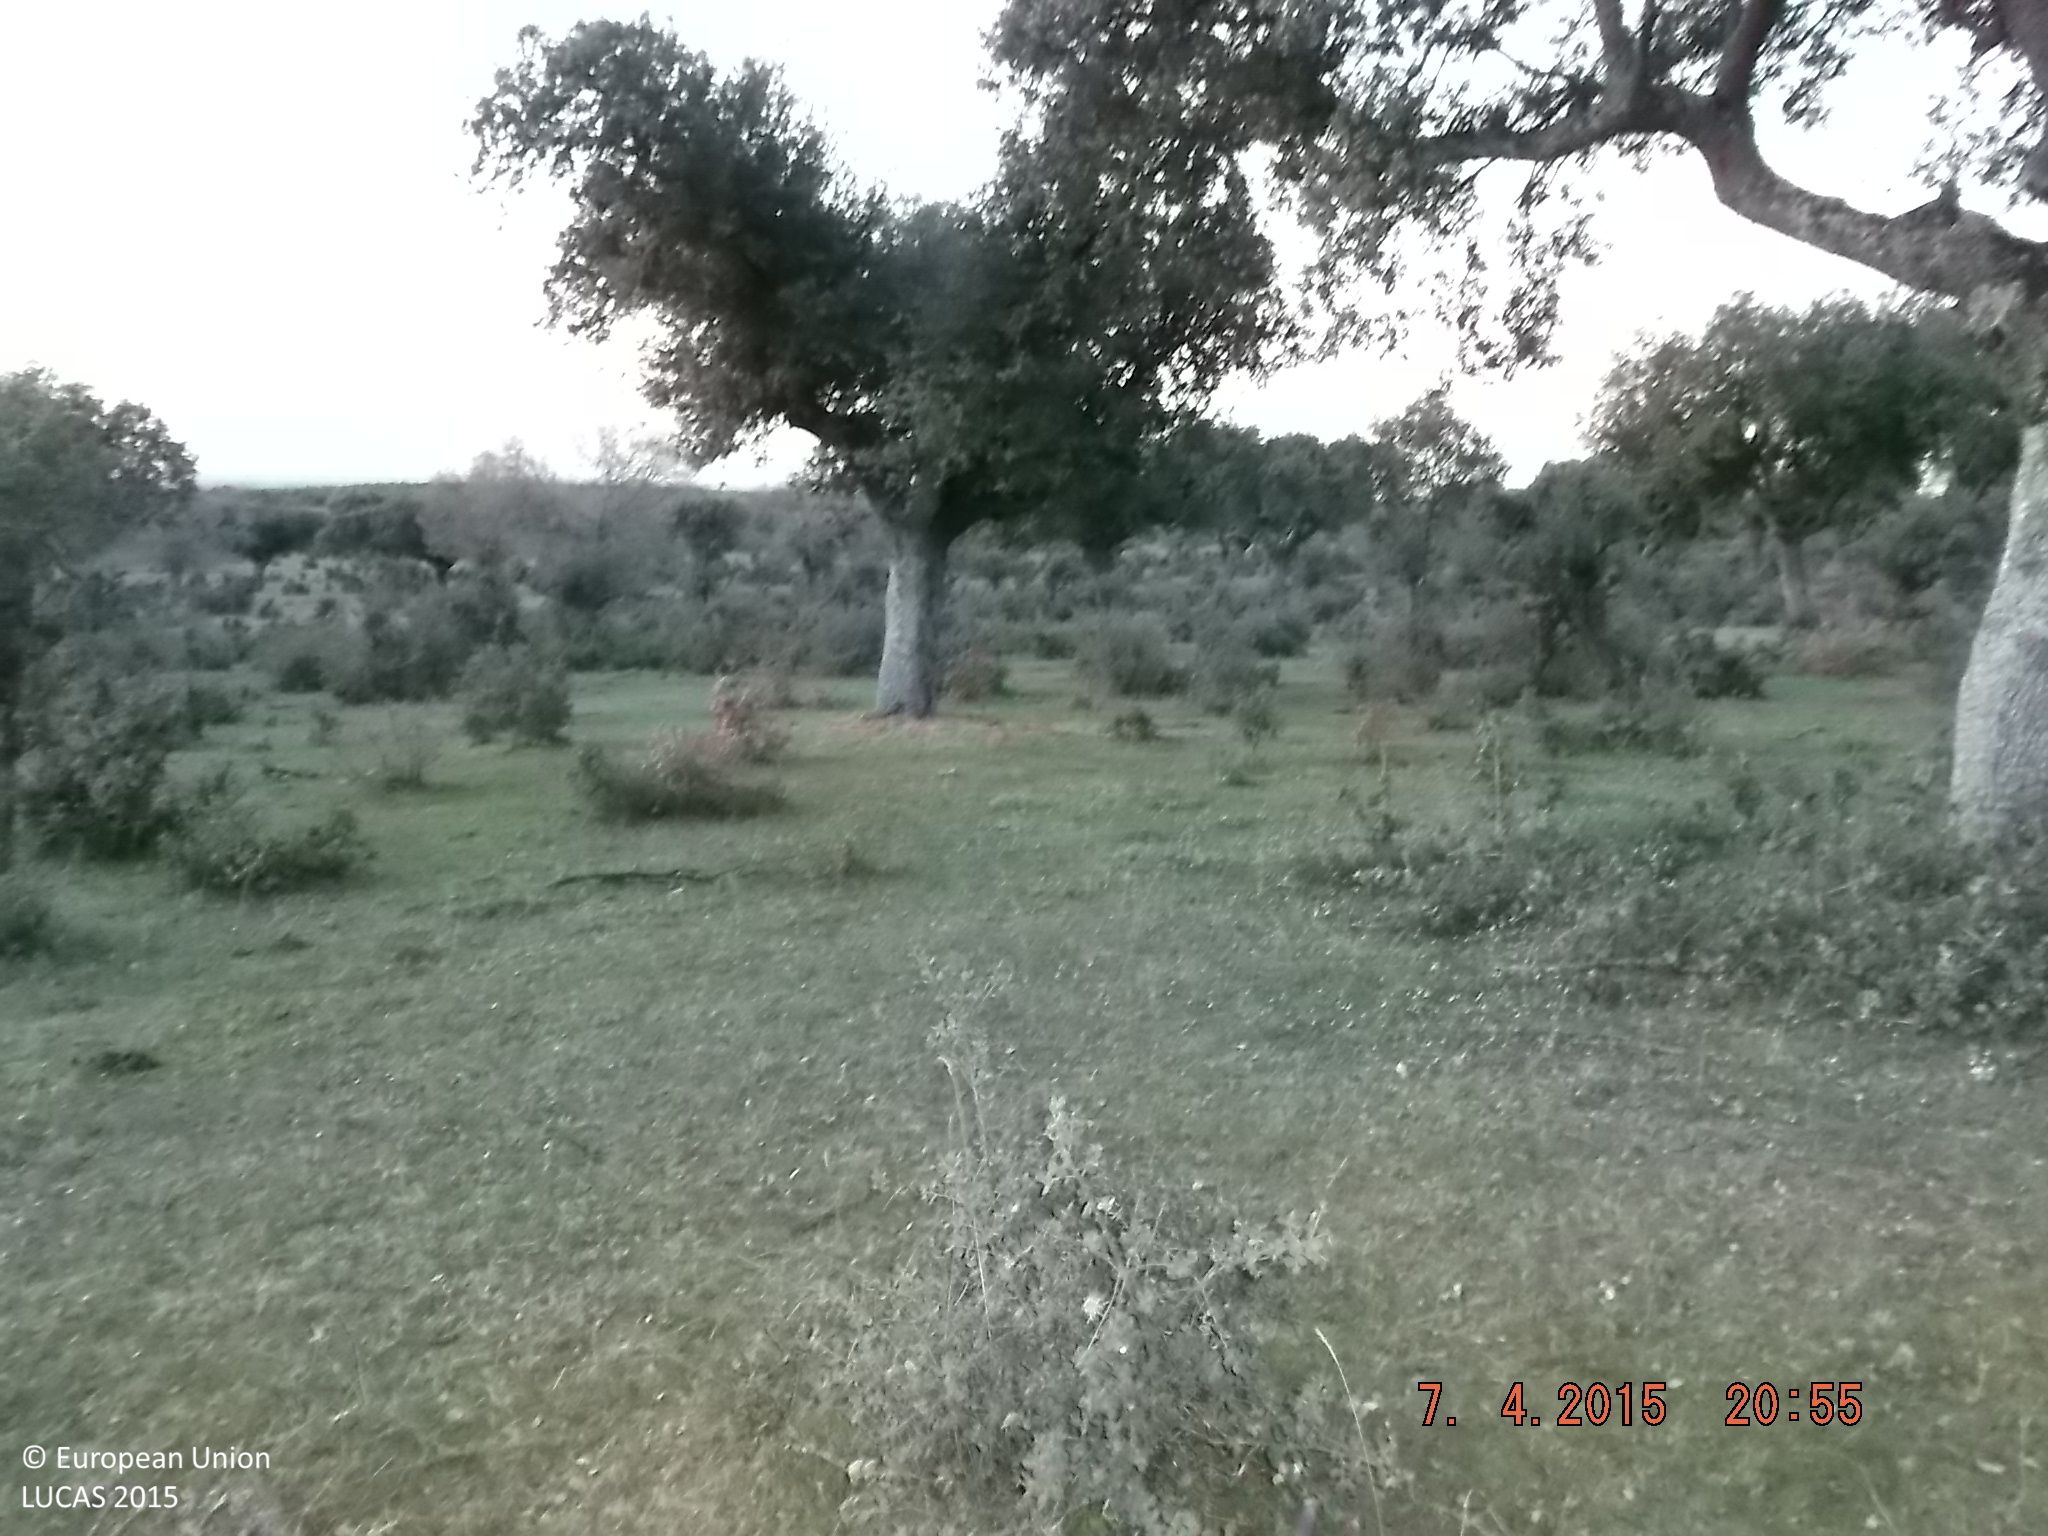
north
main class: Woodland
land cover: Broadleaved woodland
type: broadleaved evergreen forest
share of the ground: 25 - 50 %
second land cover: Shrubland without tree cover
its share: 50 - 75 %
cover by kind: shrubs 50 %, broadleaved forest trees 40 %, herbaceous plants 10 %
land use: Forestry
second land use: Agriculture (excluding fallow land and kitchen gardens)
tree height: < 5 m
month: April
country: ES
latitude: 40.8253
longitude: -5.8611
